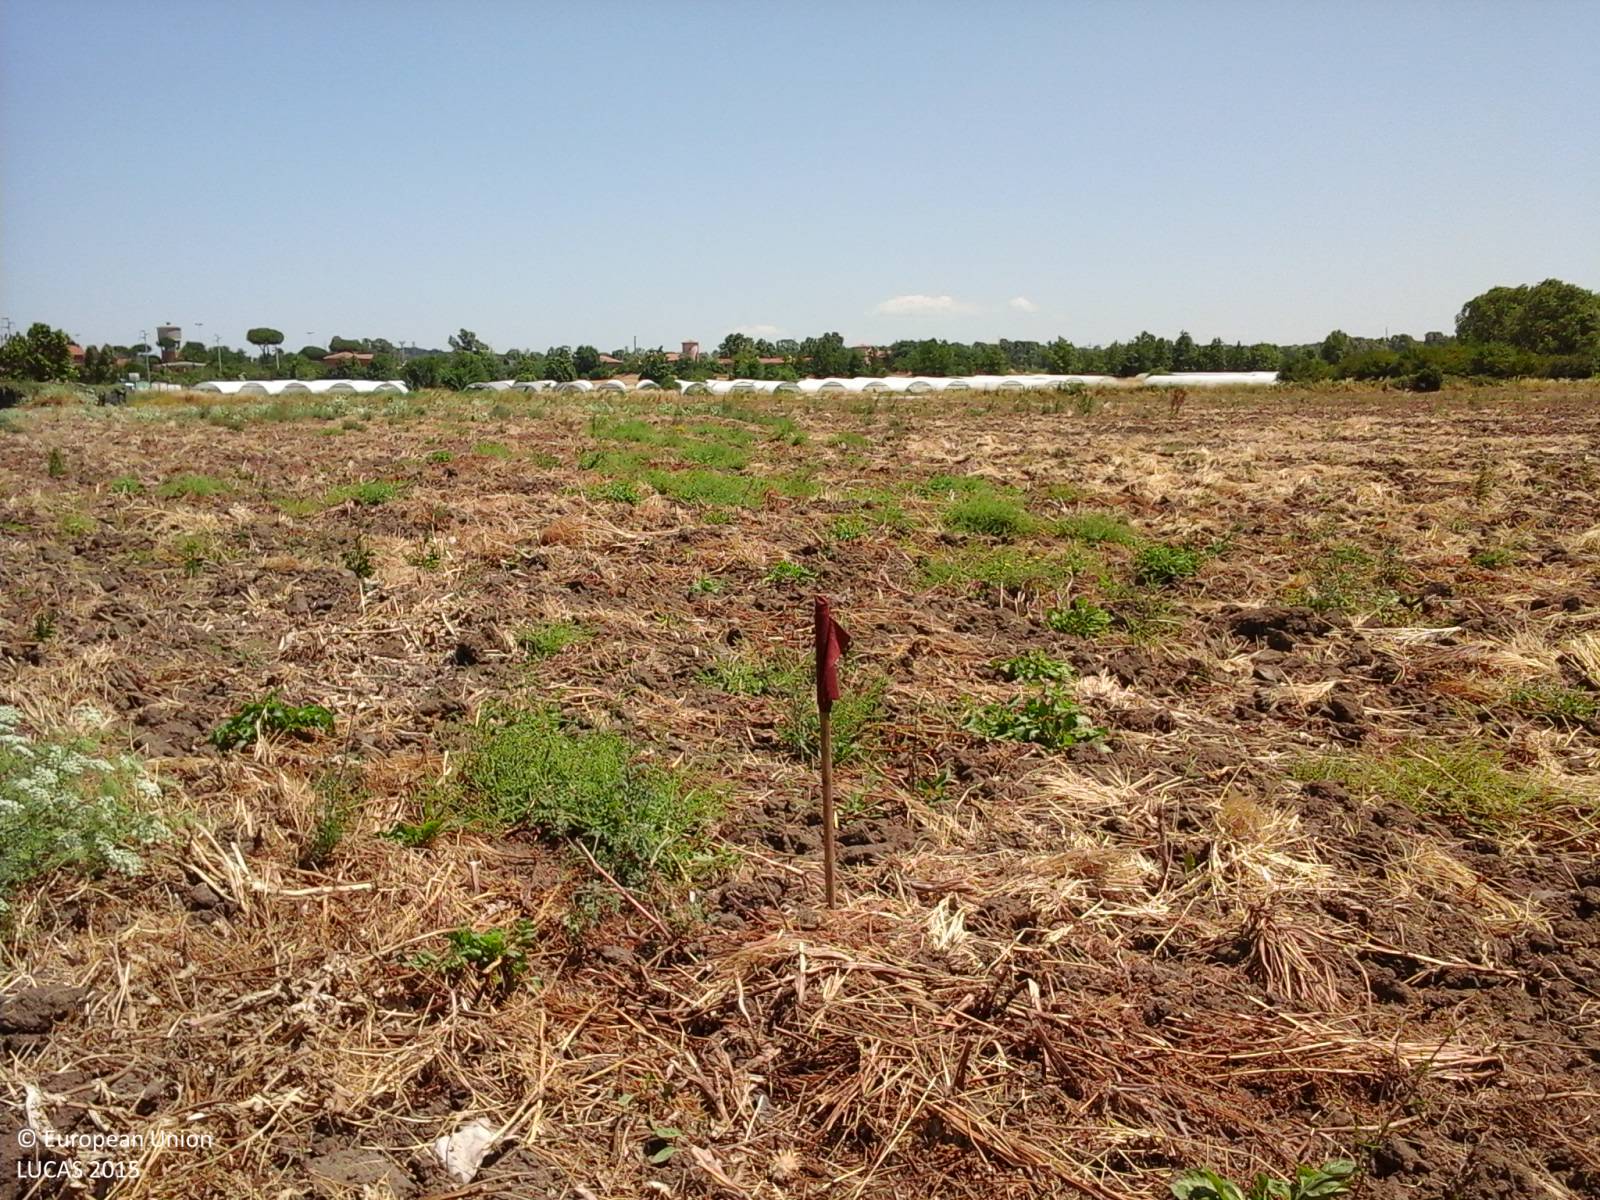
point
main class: Grassland
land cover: Spontaneously vegetated surfaces
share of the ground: < 10 %
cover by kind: unconsolidated bare surface 90 %, herbaceous plants 10 %
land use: Fallow land
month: June
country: IT
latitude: 41.9073
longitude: 12.1978
